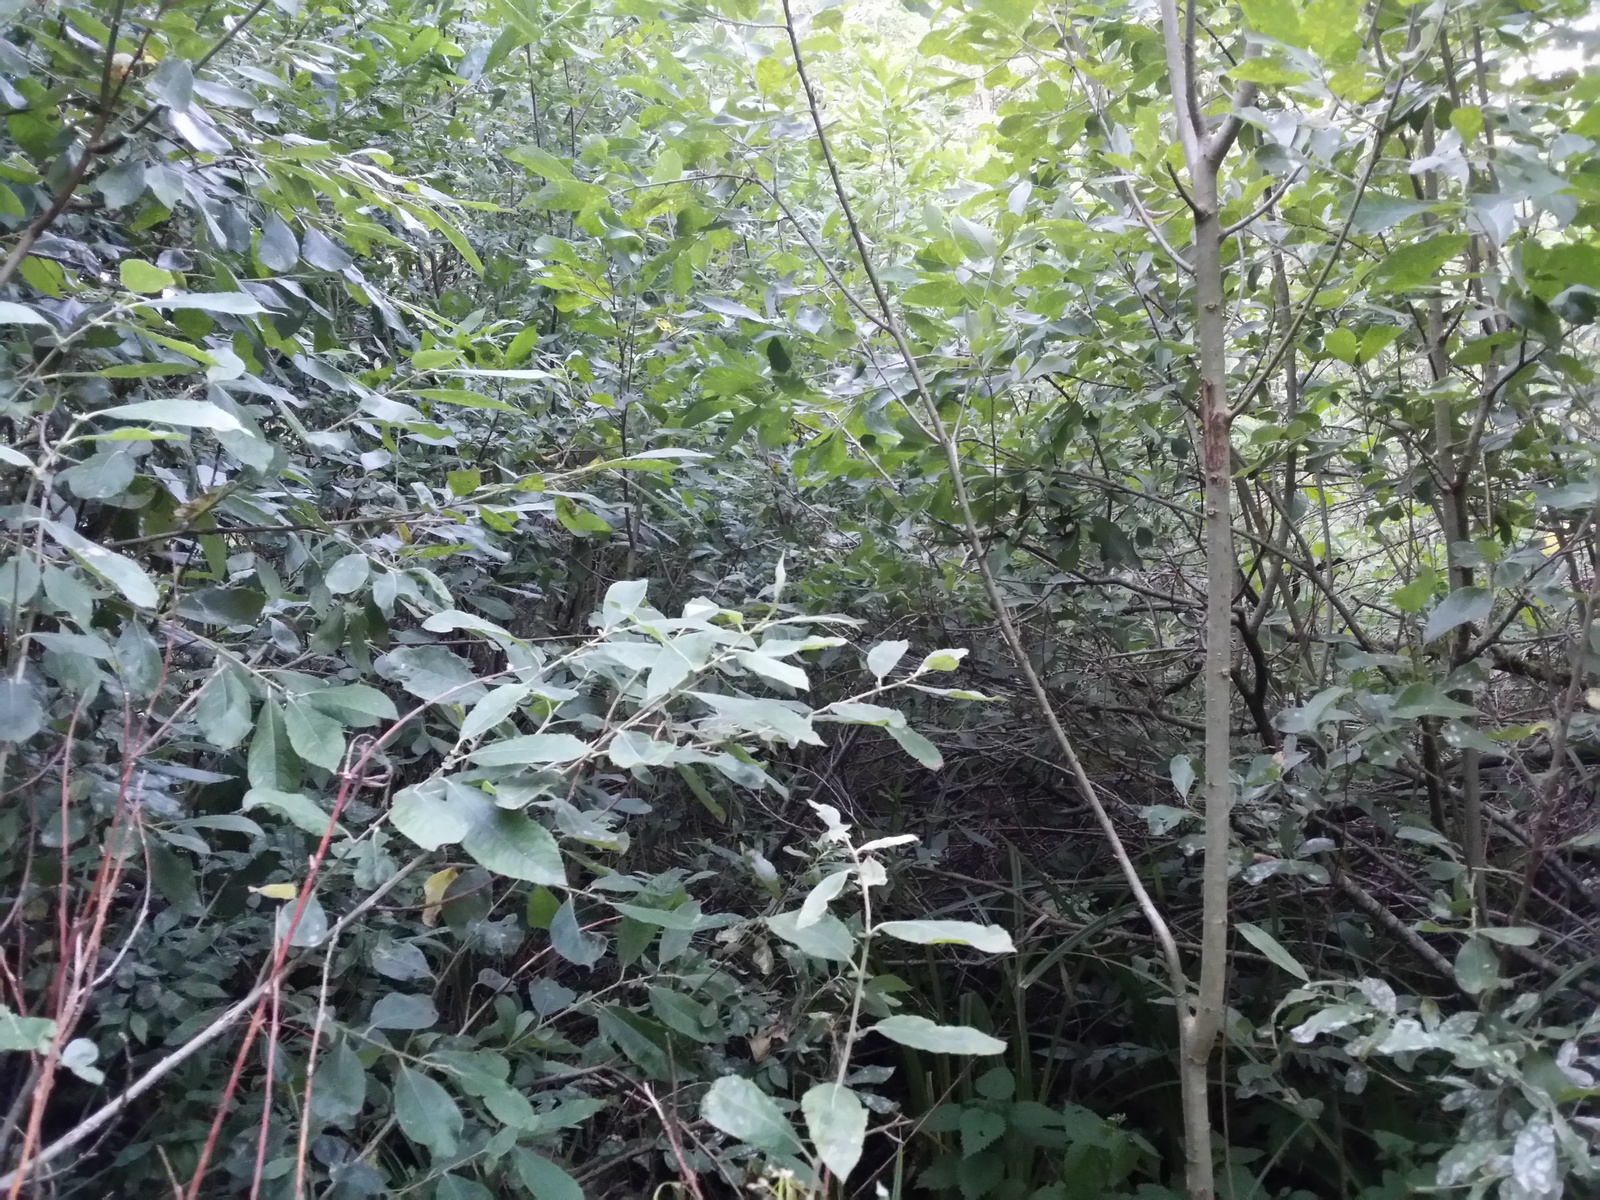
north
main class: Woodland
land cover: Broadleaved woodland
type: non-riverine alder, birch or aspen forest
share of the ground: > 75 %
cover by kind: broadleaved forest trees 90 %, shrubs 5 %, herbaceous plants 5 %
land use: Forestry
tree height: > 5 m
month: August
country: LV
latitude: 56.9215
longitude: 27.5431
